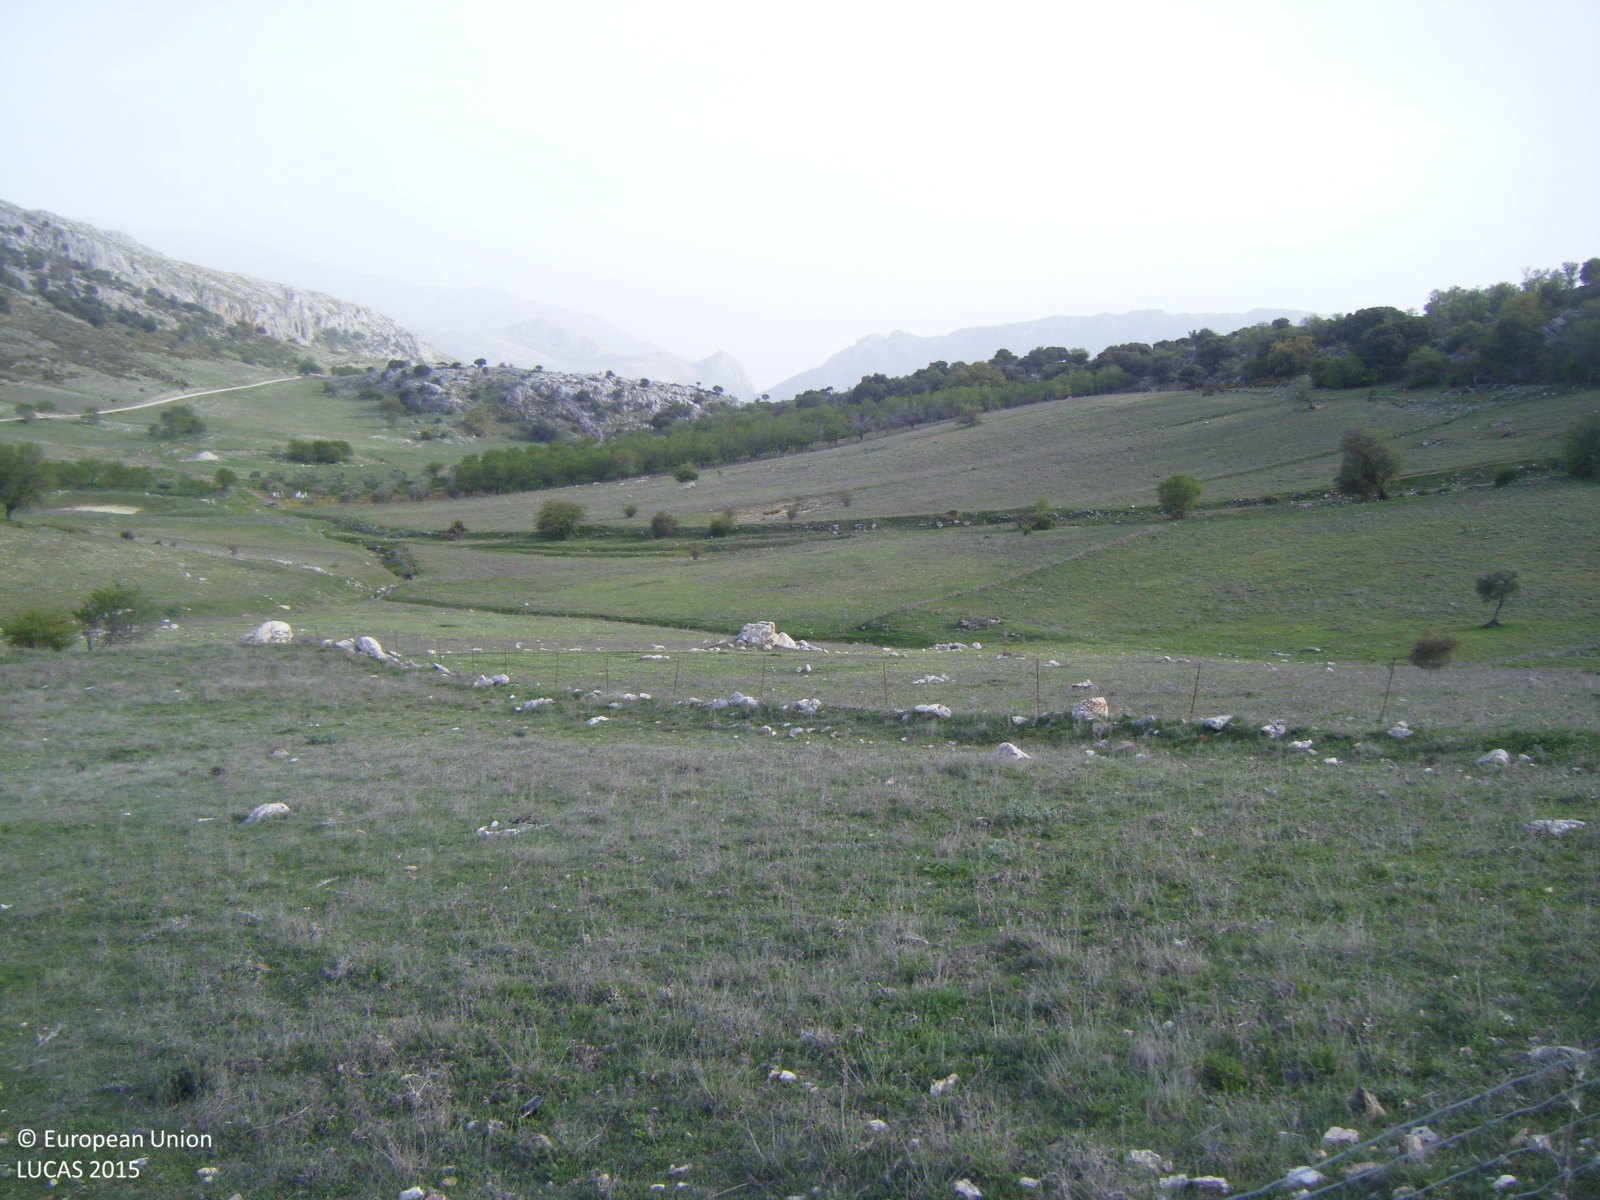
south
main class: Grassland
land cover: Grassland without tree/shrub cover
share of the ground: > 75 %
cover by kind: herbaceous plants 100 %
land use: Agriculture (excluding fallow land and kitchen gardens)
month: April
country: ES
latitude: 37.0157
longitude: -4.1423
